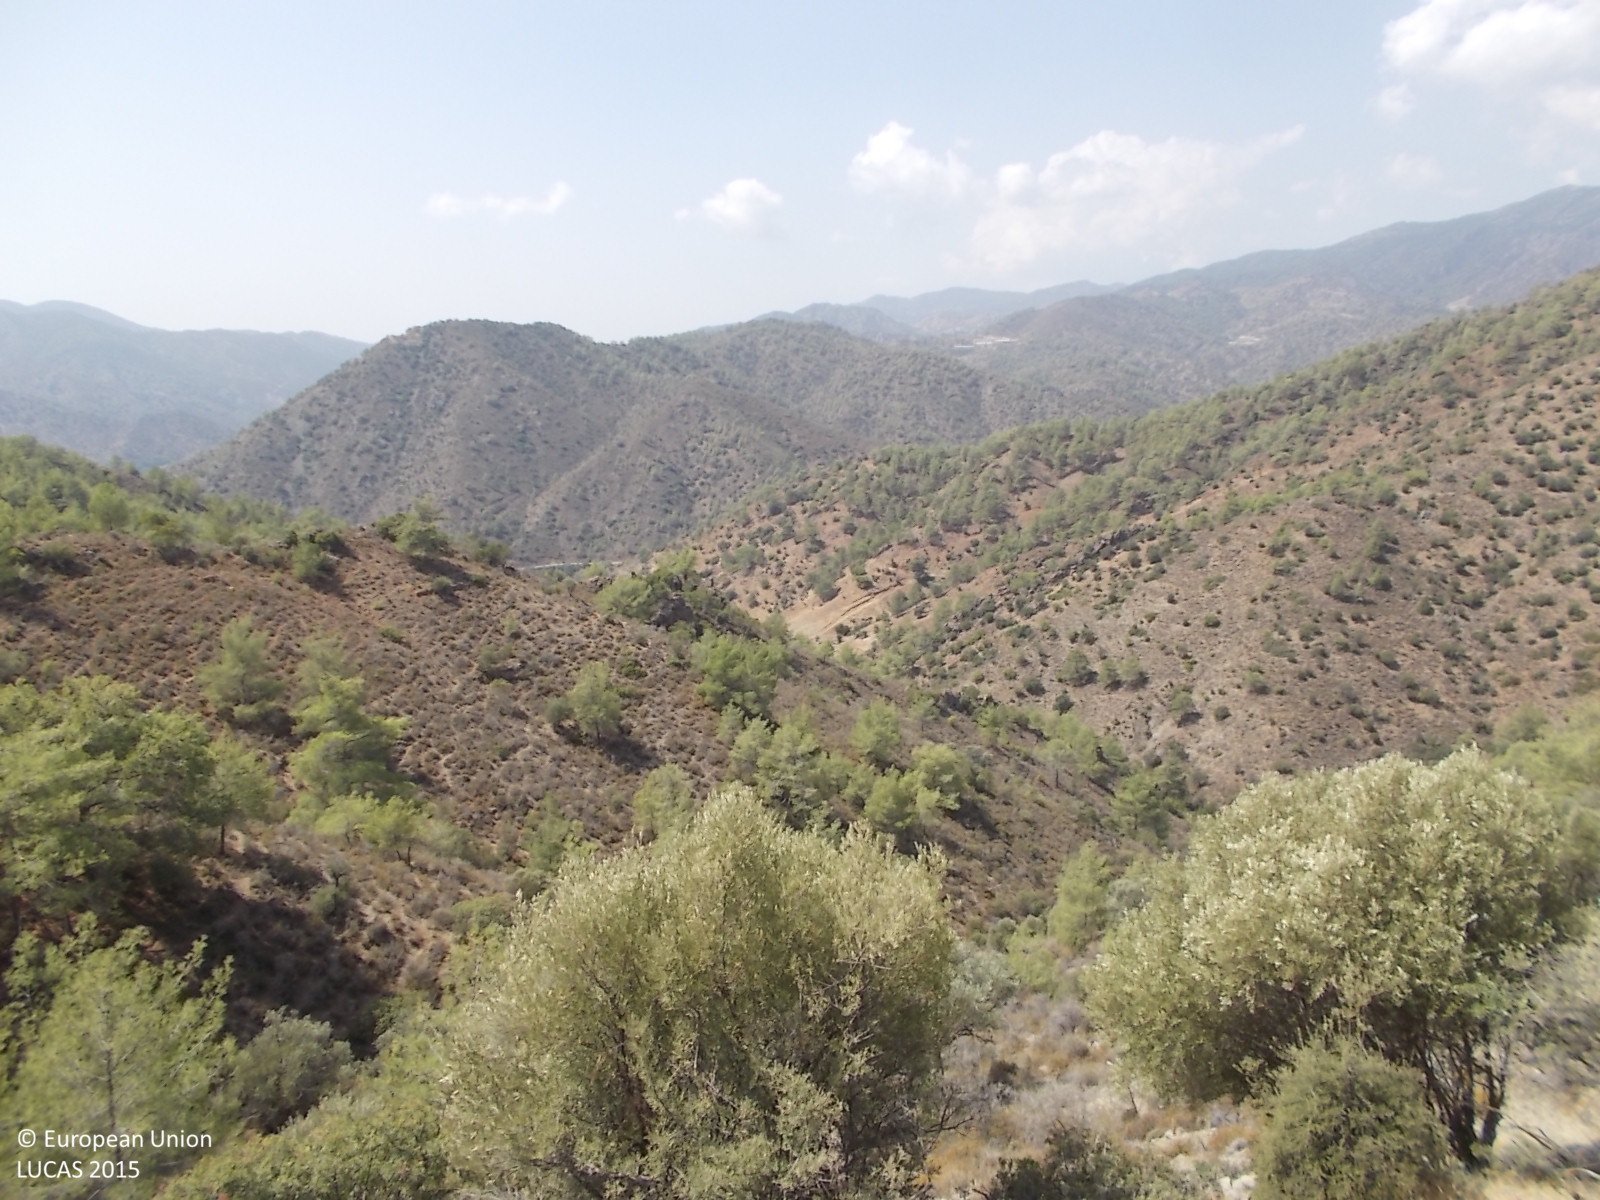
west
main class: Woodland
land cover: Pine dominated mixed woodland
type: coniferous forest of the mediterranean region
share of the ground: 50 - 75 %
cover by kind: coniferous forest trees 40 %, unconsolidated bare surface 35 %, broadleaved forest trees 15 %, shrubs 10 %
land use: Semi-natural and natural areas not in use
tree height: > 5 m
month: April
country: CY
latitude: 34.8540
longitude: 33.1316
